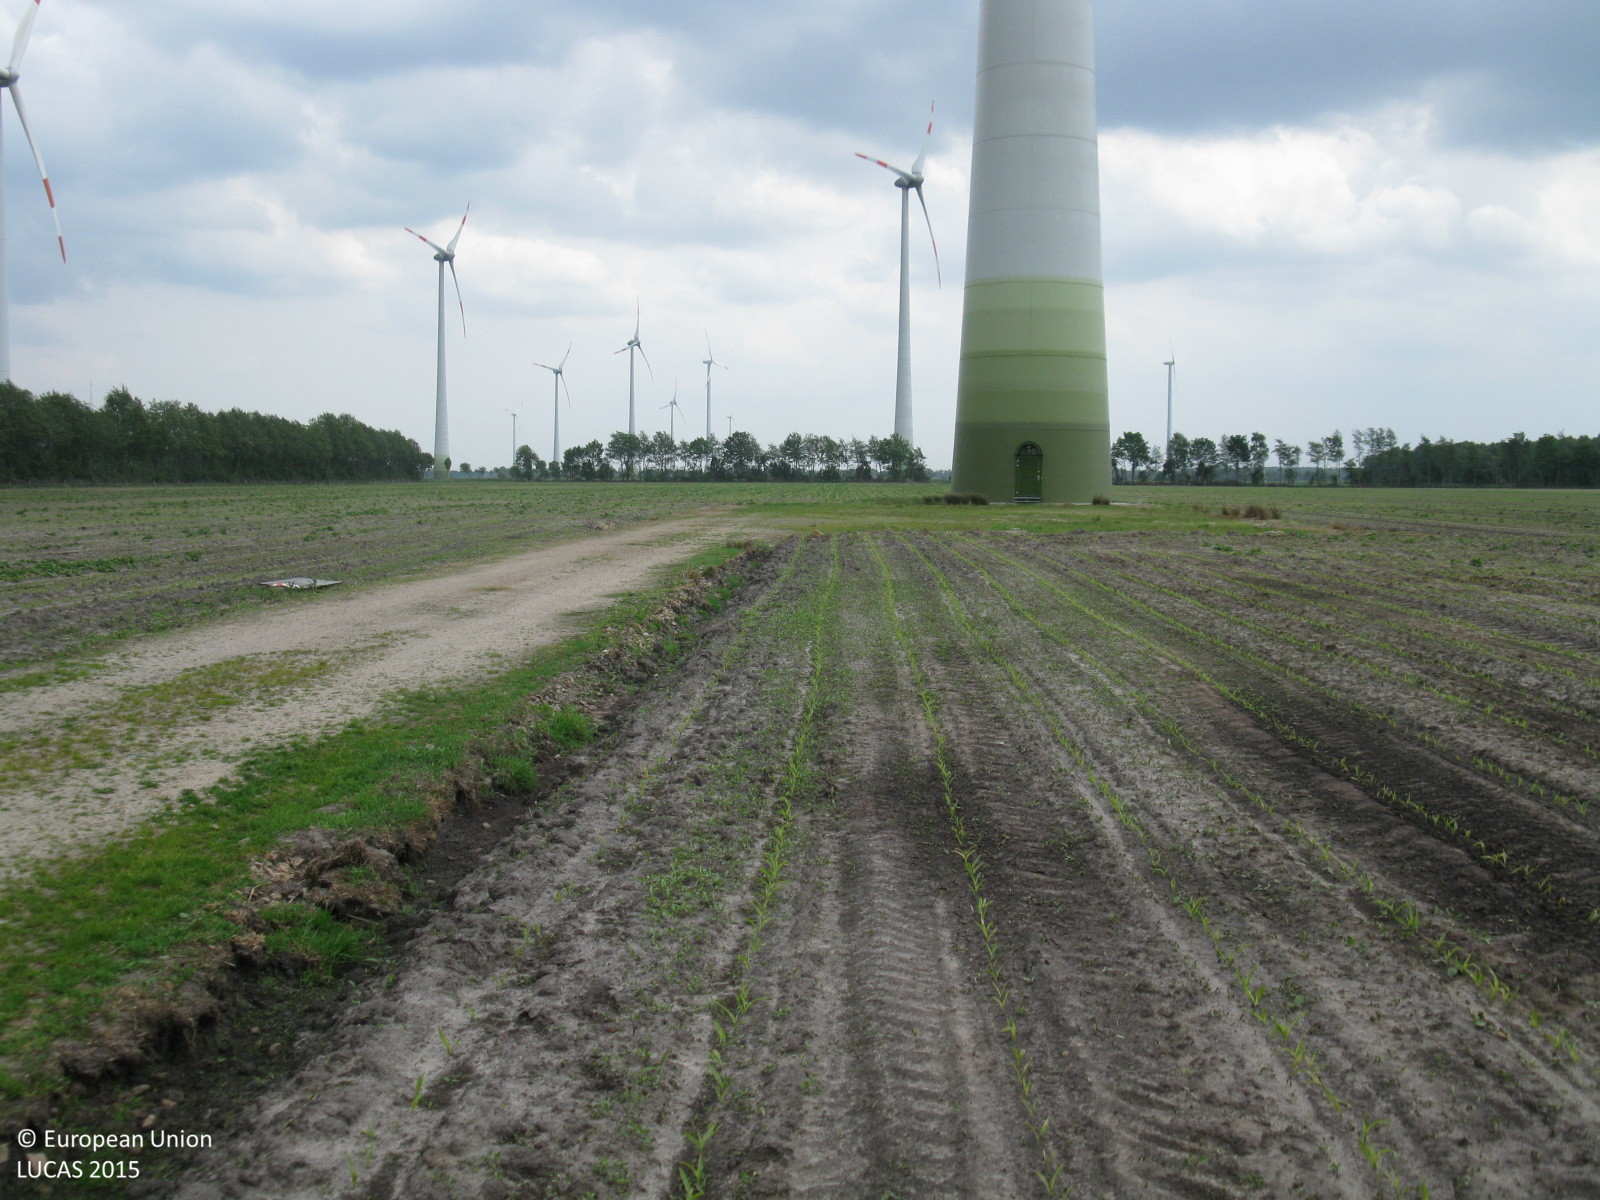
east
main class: Cropland
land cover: Maize
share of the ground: < 10 %
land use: Agriculture (excluding fallow land and kitchen gardens)
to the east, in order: Maize; Spontaneously vegetated surfaces; Artificial constructions; Spontaneously vegetated surfaces; Maize
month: May
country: DE
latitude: 52.9789
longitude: 7.4240
